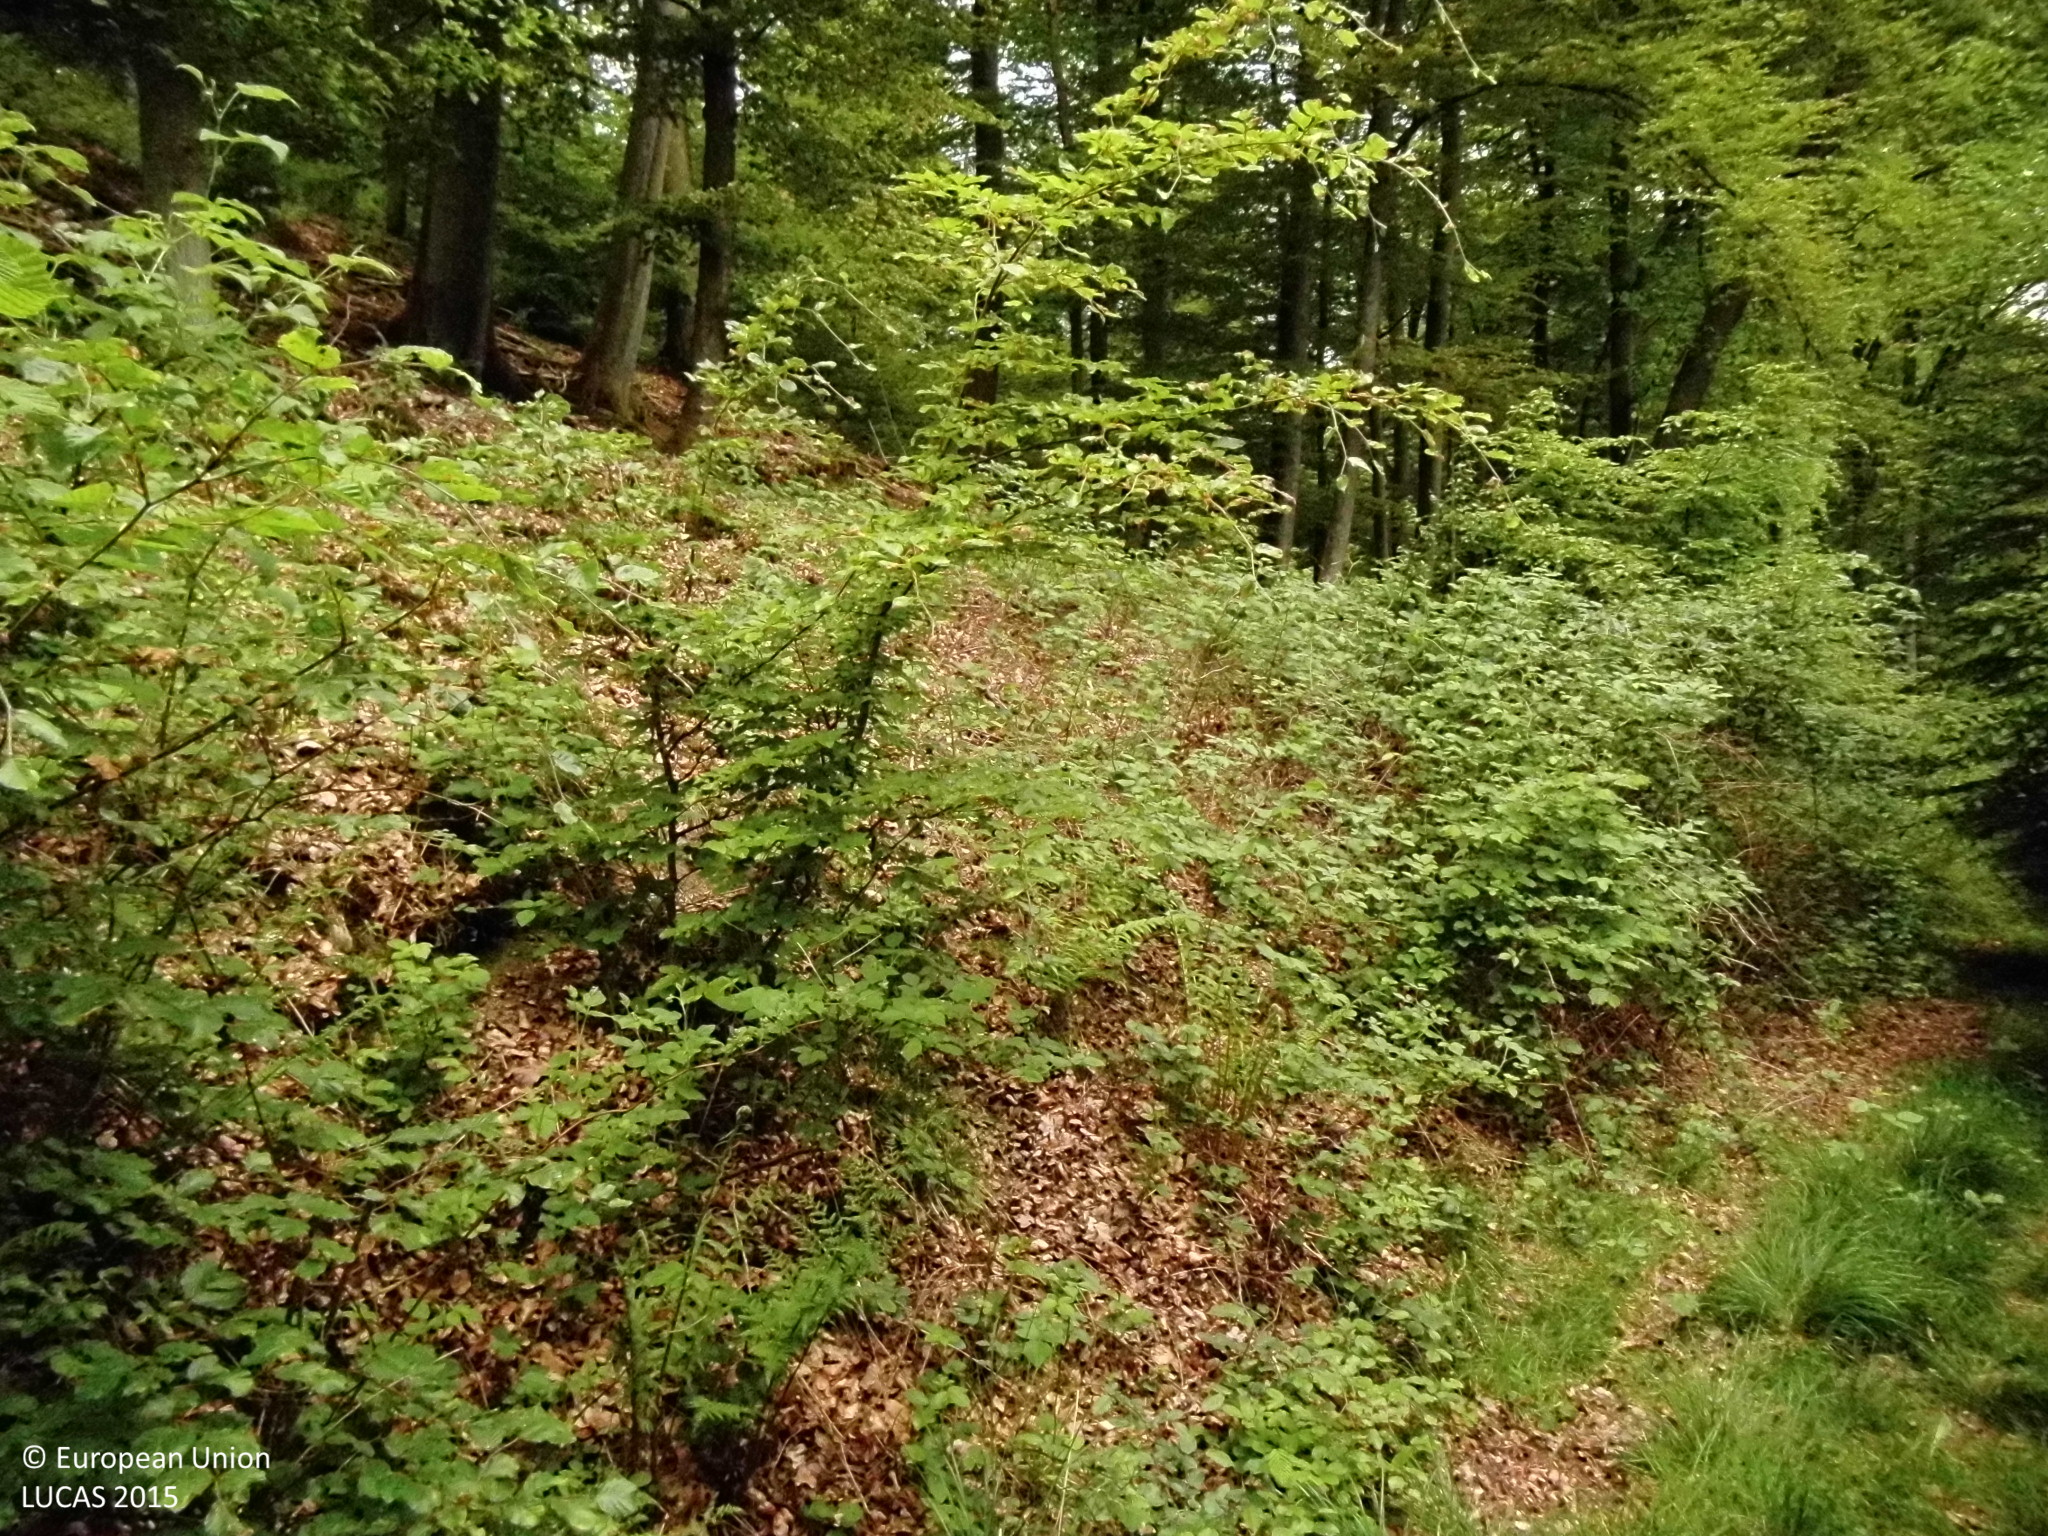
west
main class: Woodland
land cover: Broadleaved woodland
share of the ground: 50 - 75 %
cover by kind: broadleaved forest trees 70 %, shrubs 15 %, herbaceous plants 15 %
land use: Forestry
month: May
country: DE
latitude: 50.5527
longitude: 7.5021
